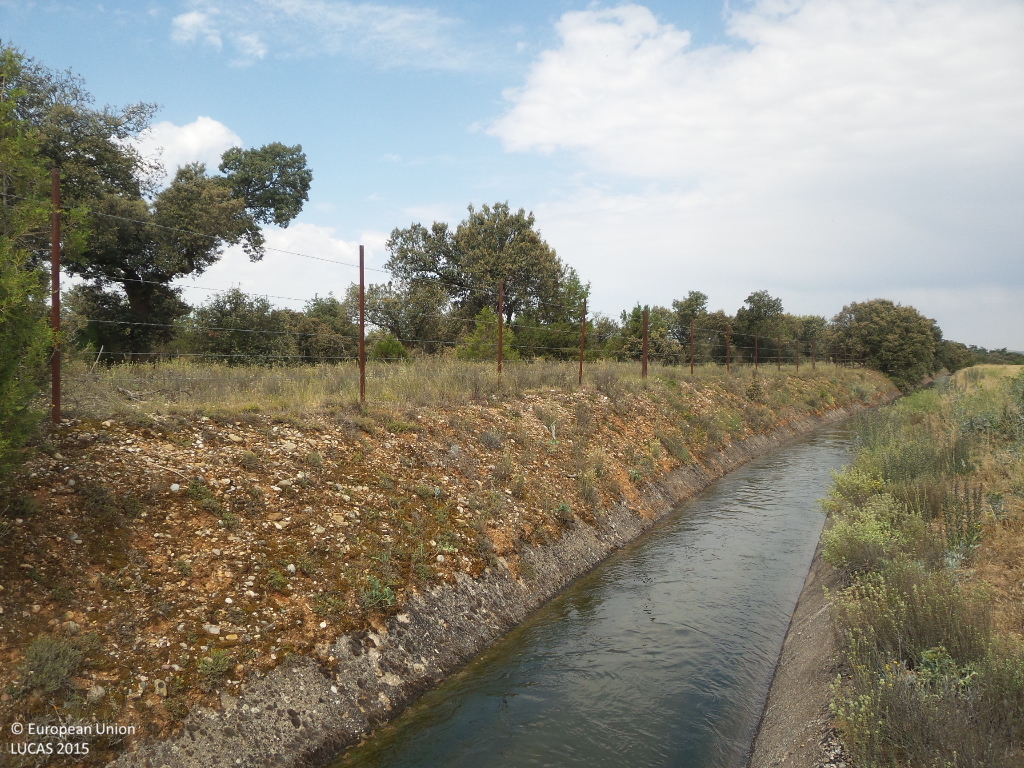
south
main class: Woodland
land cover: Broadleaved woodland
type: broadleaved evergreen forest
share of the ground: 10 - 25 %
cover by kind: herbaceous plants 40 %, shrubs 25 %, broadleaved forest trees 20 %, unconsolidated bare surface 10 %, coniferous forest trees 5 %
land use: Forestry
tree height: > 5 m
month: June
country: ES
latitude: 41.5258
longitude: -3.0938
